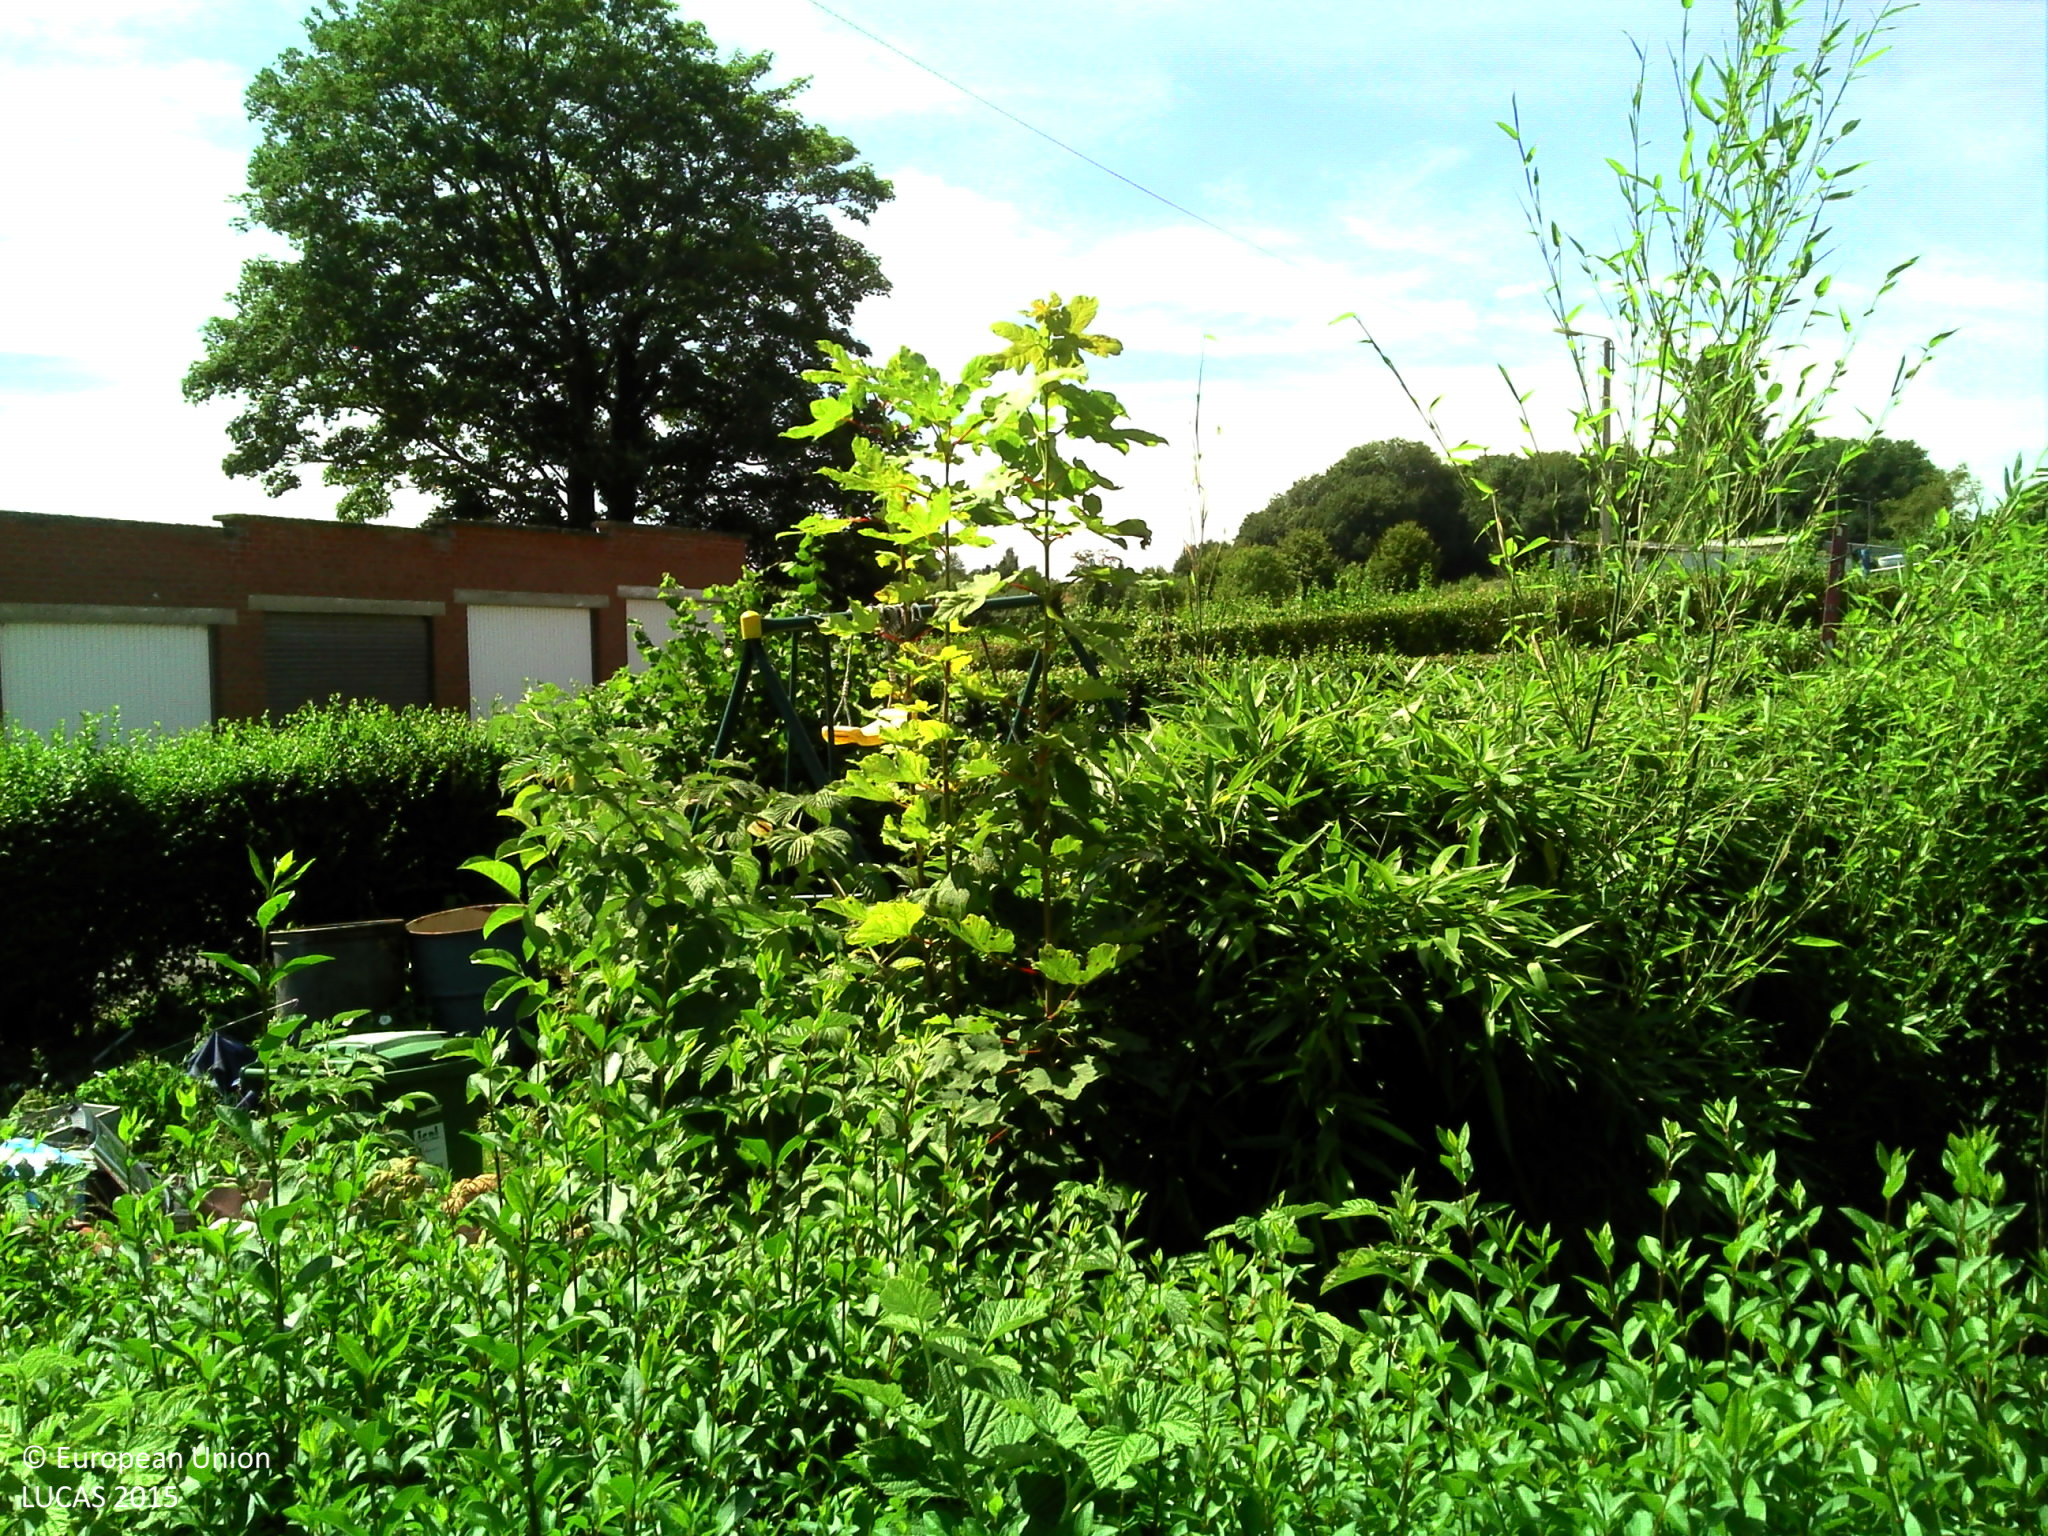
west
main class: Grassland
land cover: Grassland without tree/shrub cover
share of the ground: > 75 %
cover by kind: herbaceous plants 100 %
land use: Residential
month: August
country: BE
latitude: 50.3593
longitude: 4.5280
